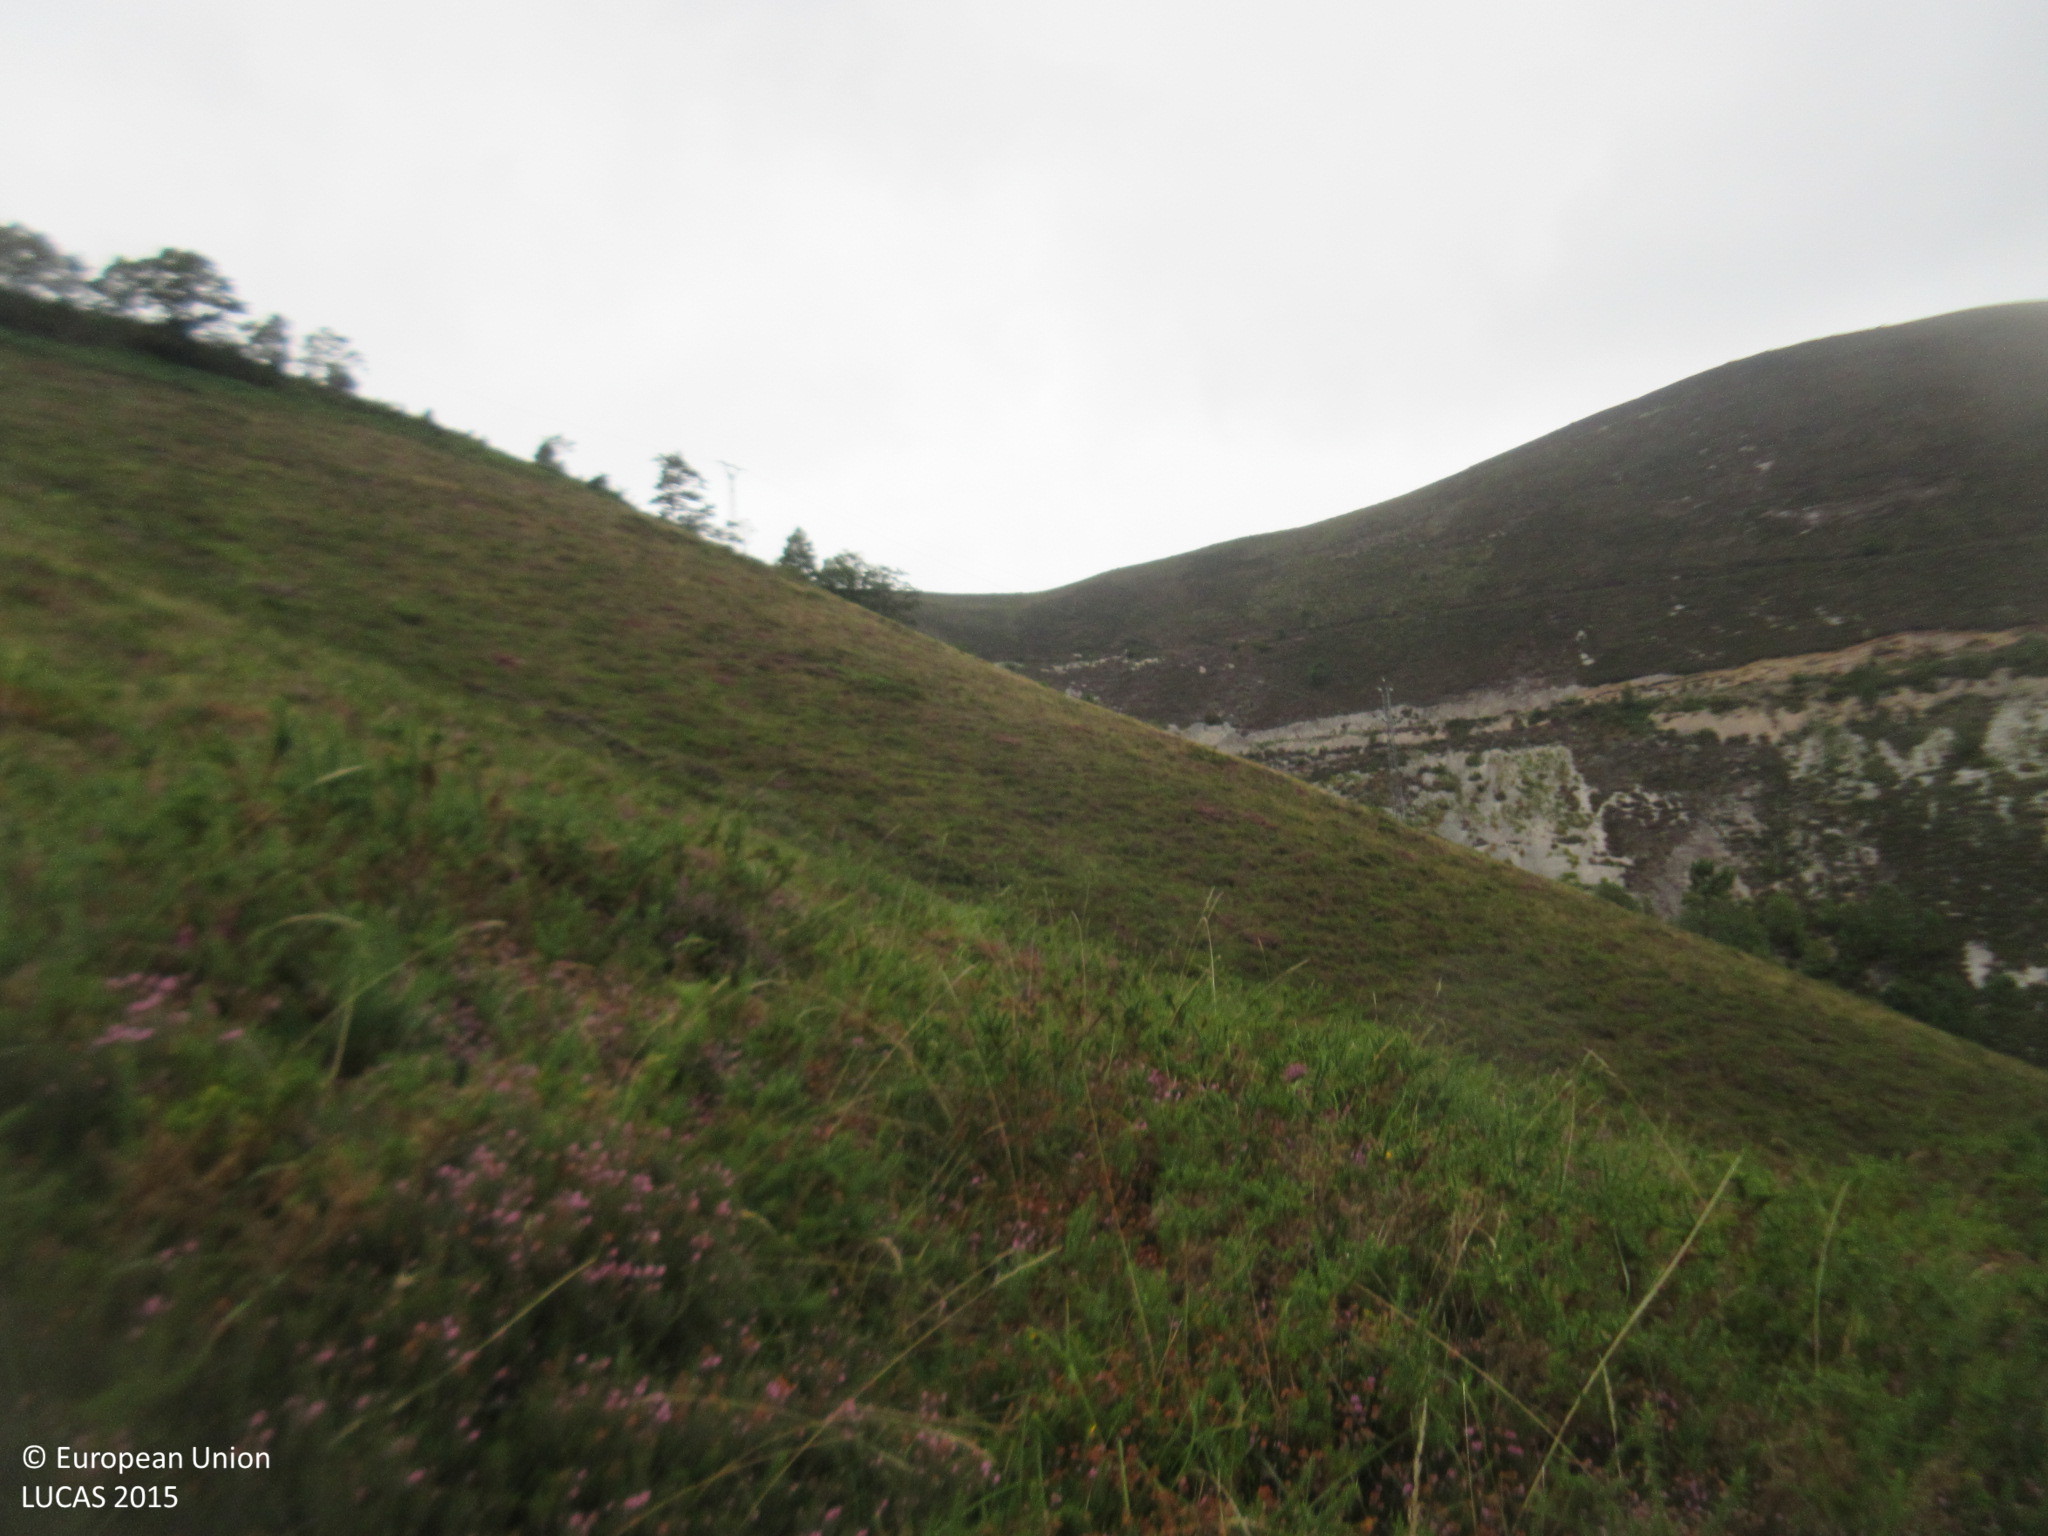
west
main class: Shrubland
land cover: Shrubland without tree cover
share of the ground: > 75 %
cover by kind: shrubs 100 %
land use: Agriculture (excluding fallow land and kitchen gardens)
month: August
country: ES
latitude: 43.3905
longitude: -6.5863
